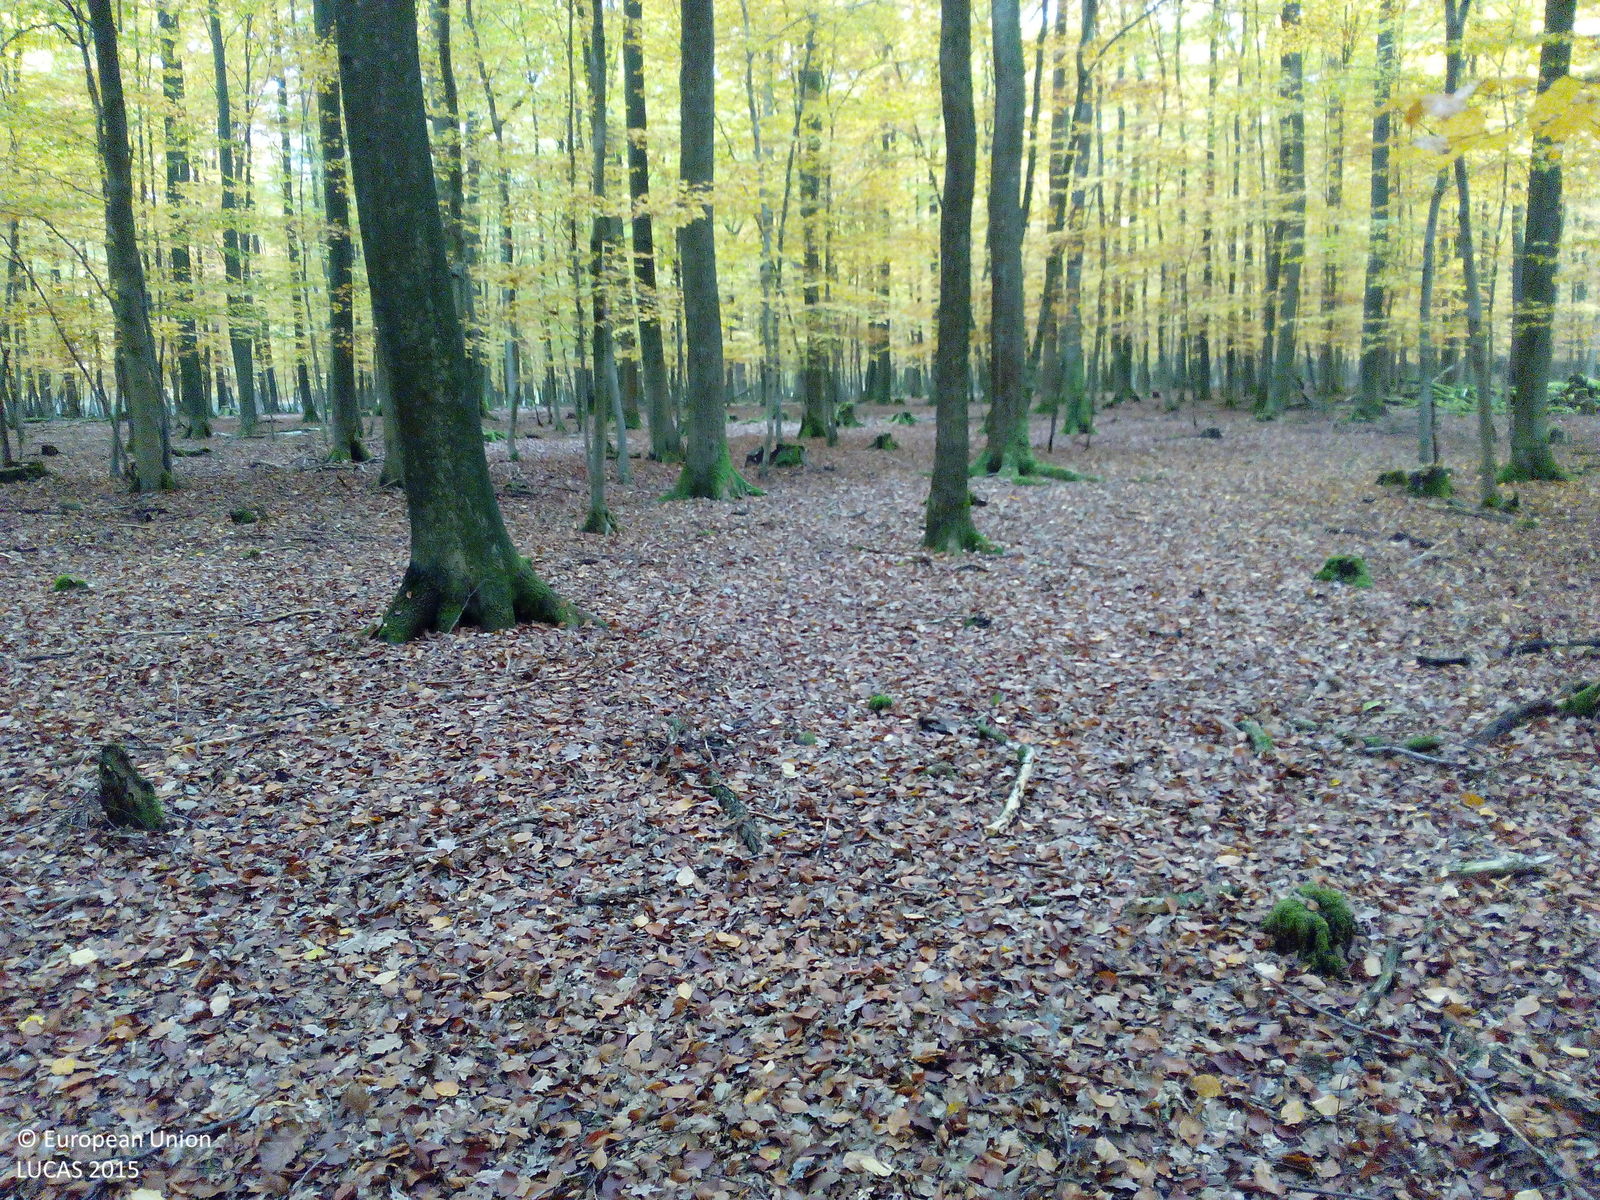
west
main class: Woodland
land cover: Broadleaved woodland
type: mesophytic deciduous forest
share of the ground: > 75 %
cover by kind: broadleaved forest trees 75 %, unconsolidated bare surface 15 %, lichens and mosses 10 %
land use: Forestry
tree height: > 5 m
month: October
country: DE
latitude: 50.2202
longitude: 9.9299
